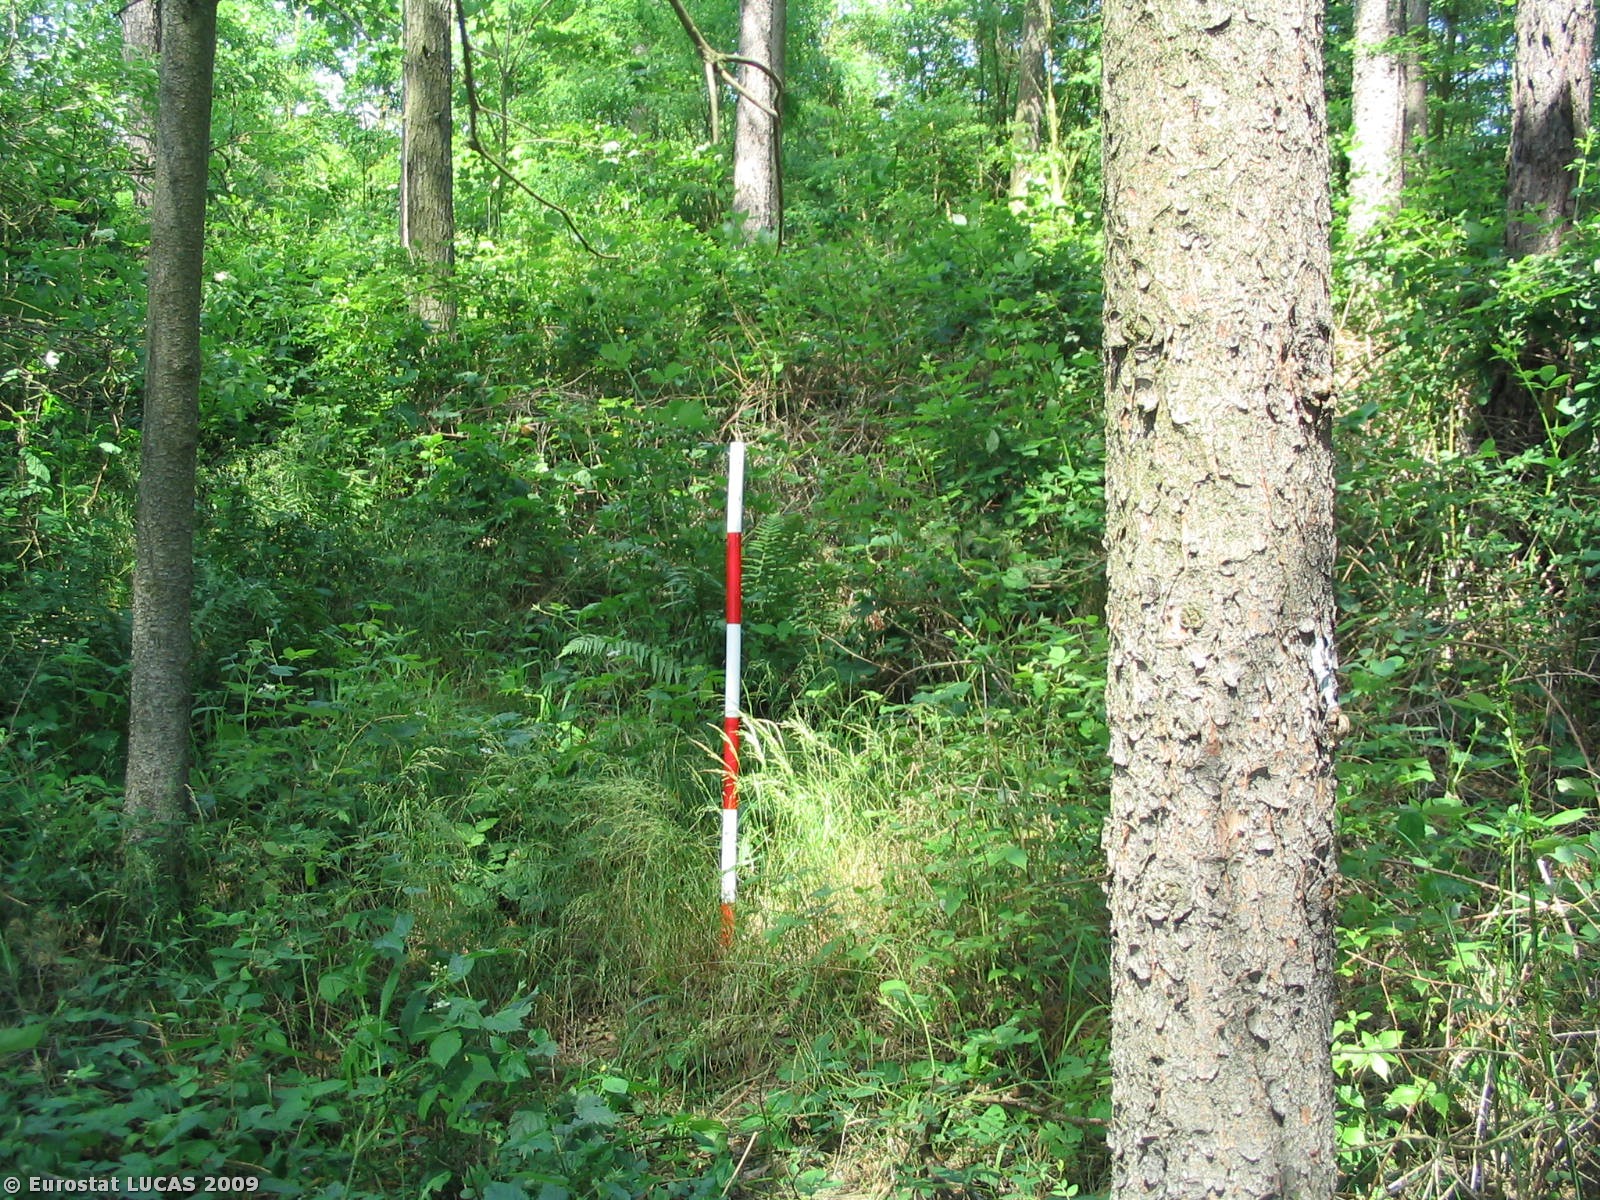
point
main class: Woodland
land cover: Mixed woodland
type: hemiboreal forest and nemoral coniferous forest and mixed broadleaved-coniferous forest
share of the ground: > 75 %
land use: Forestry
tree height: > 5 m
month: June
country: CZ
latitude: 49.3334
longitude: 16.4609
